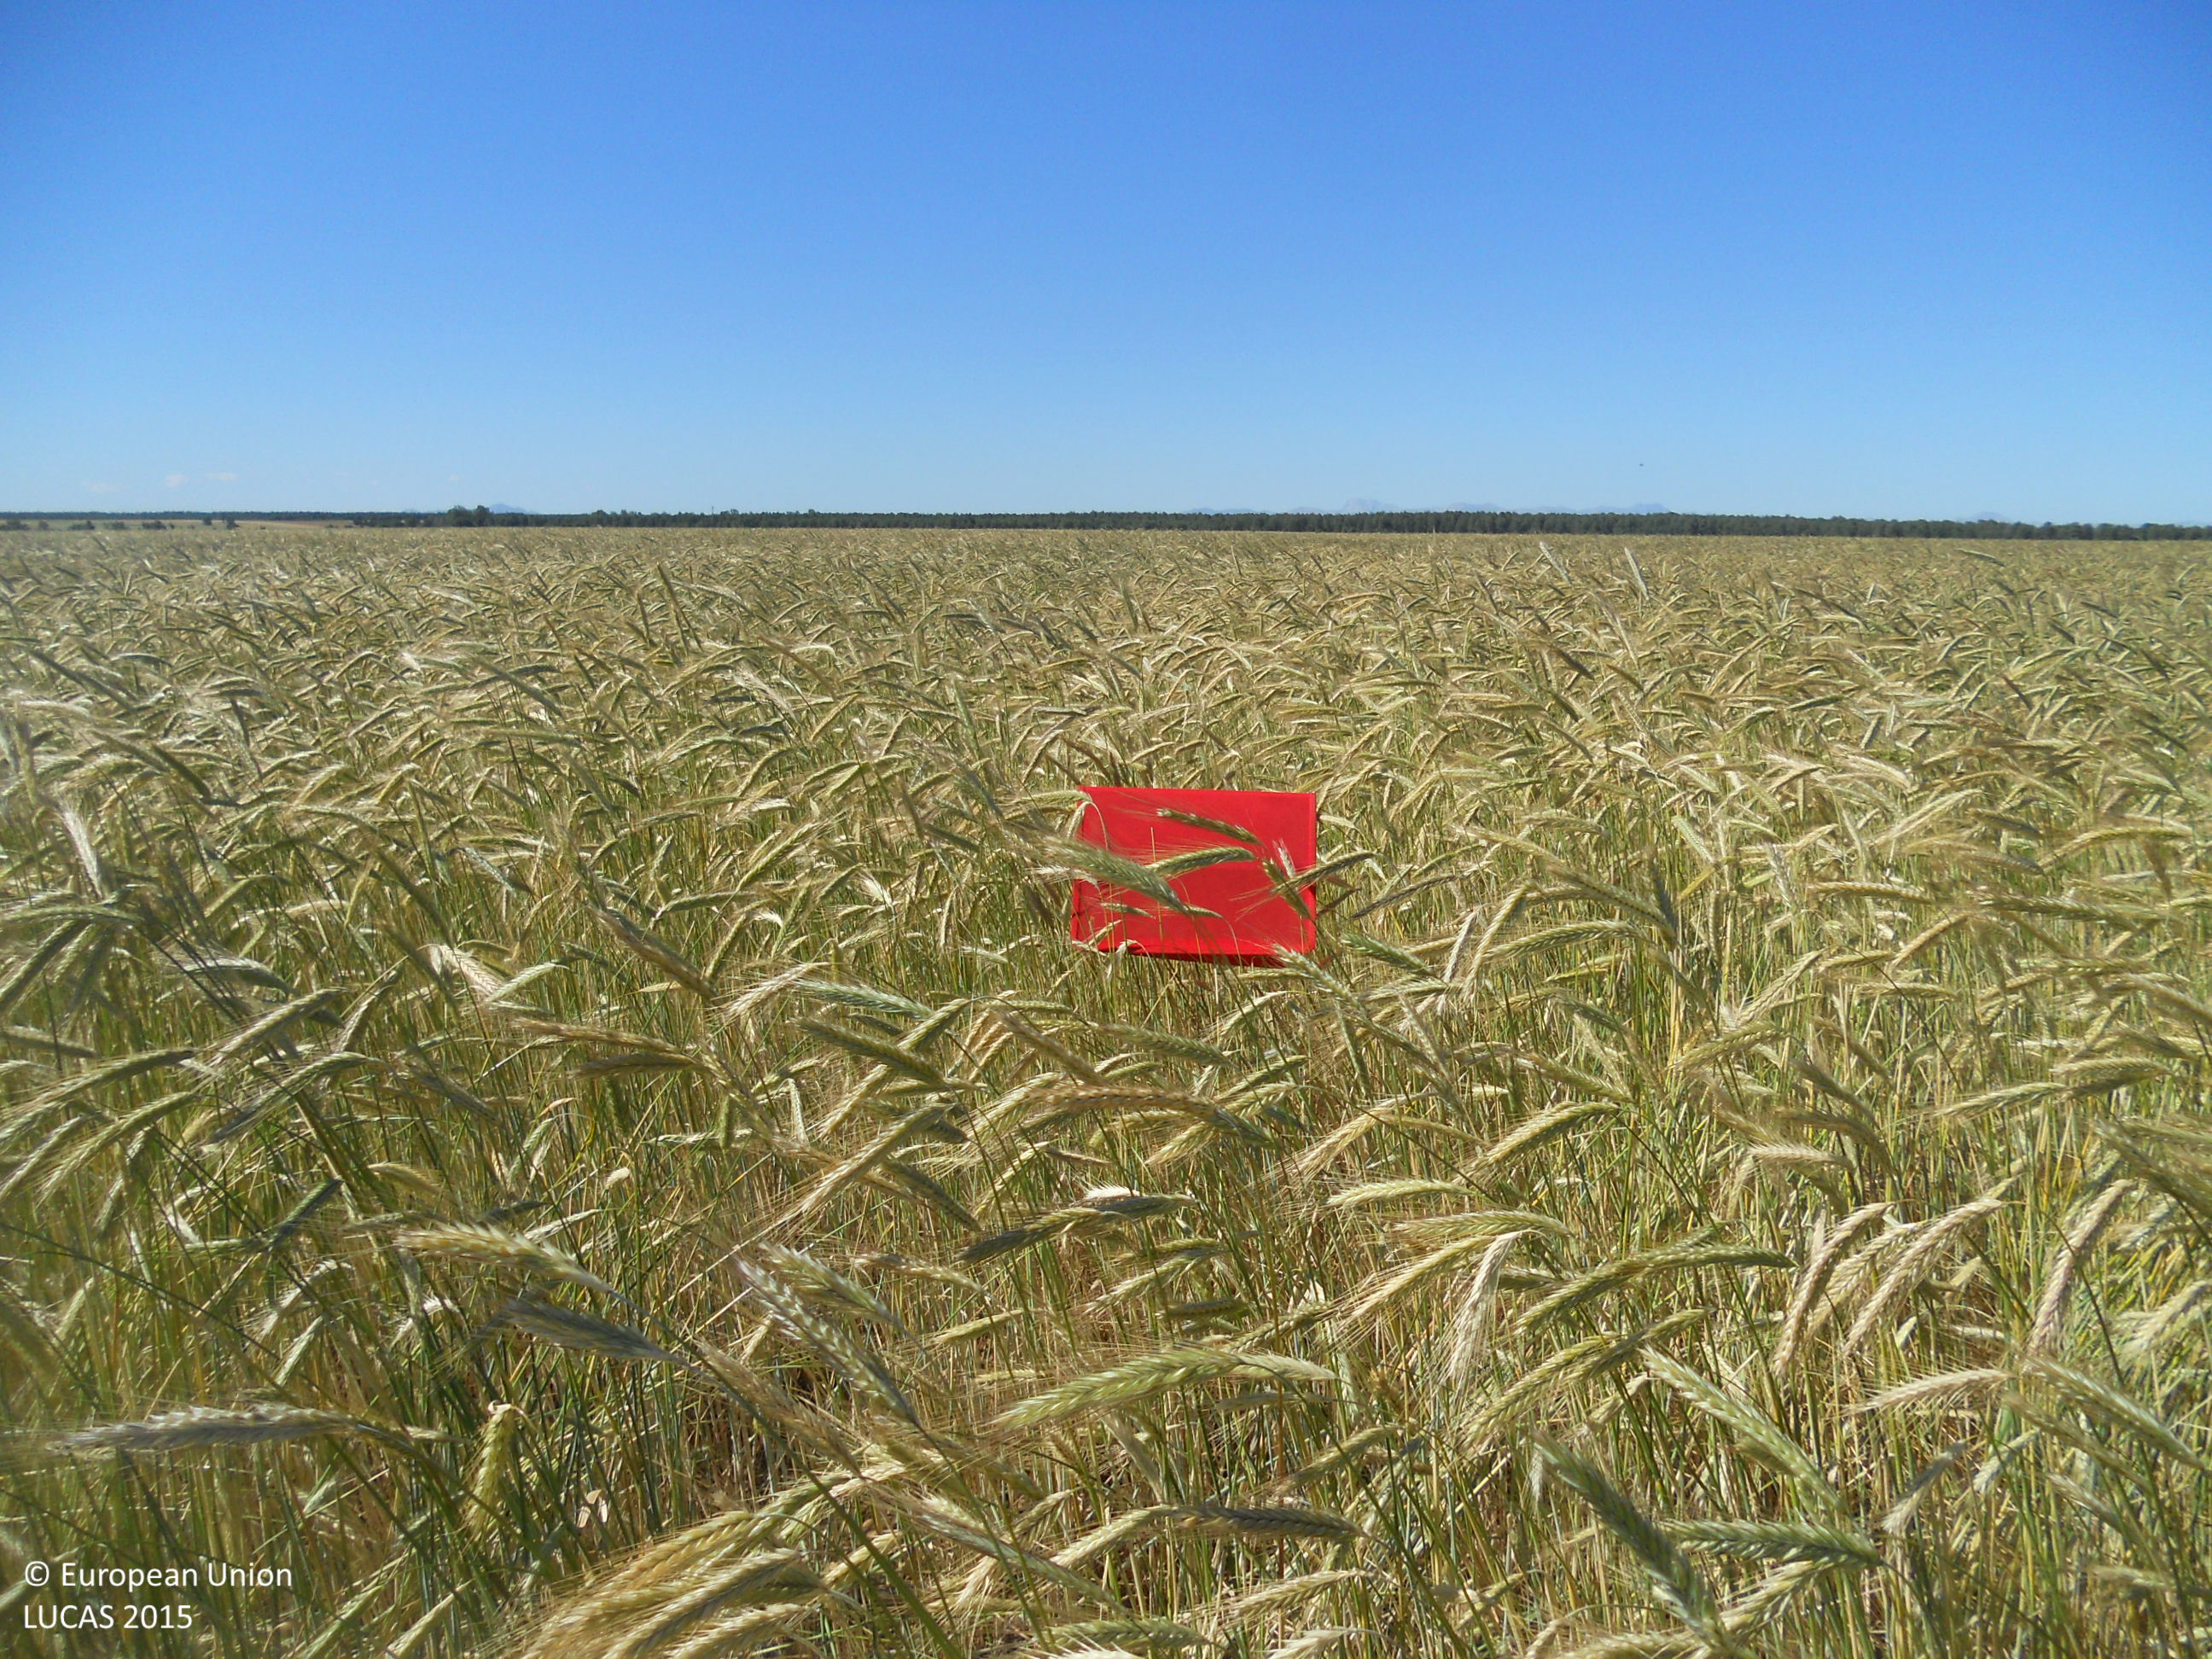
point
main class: Cropland
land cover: Rye
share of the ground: > 75 %
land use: Agriculture (excluding fallow land and kitchen gardens)
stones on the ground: > 50 %
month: June
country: ES
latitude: 42.4535
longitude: -4.8303
